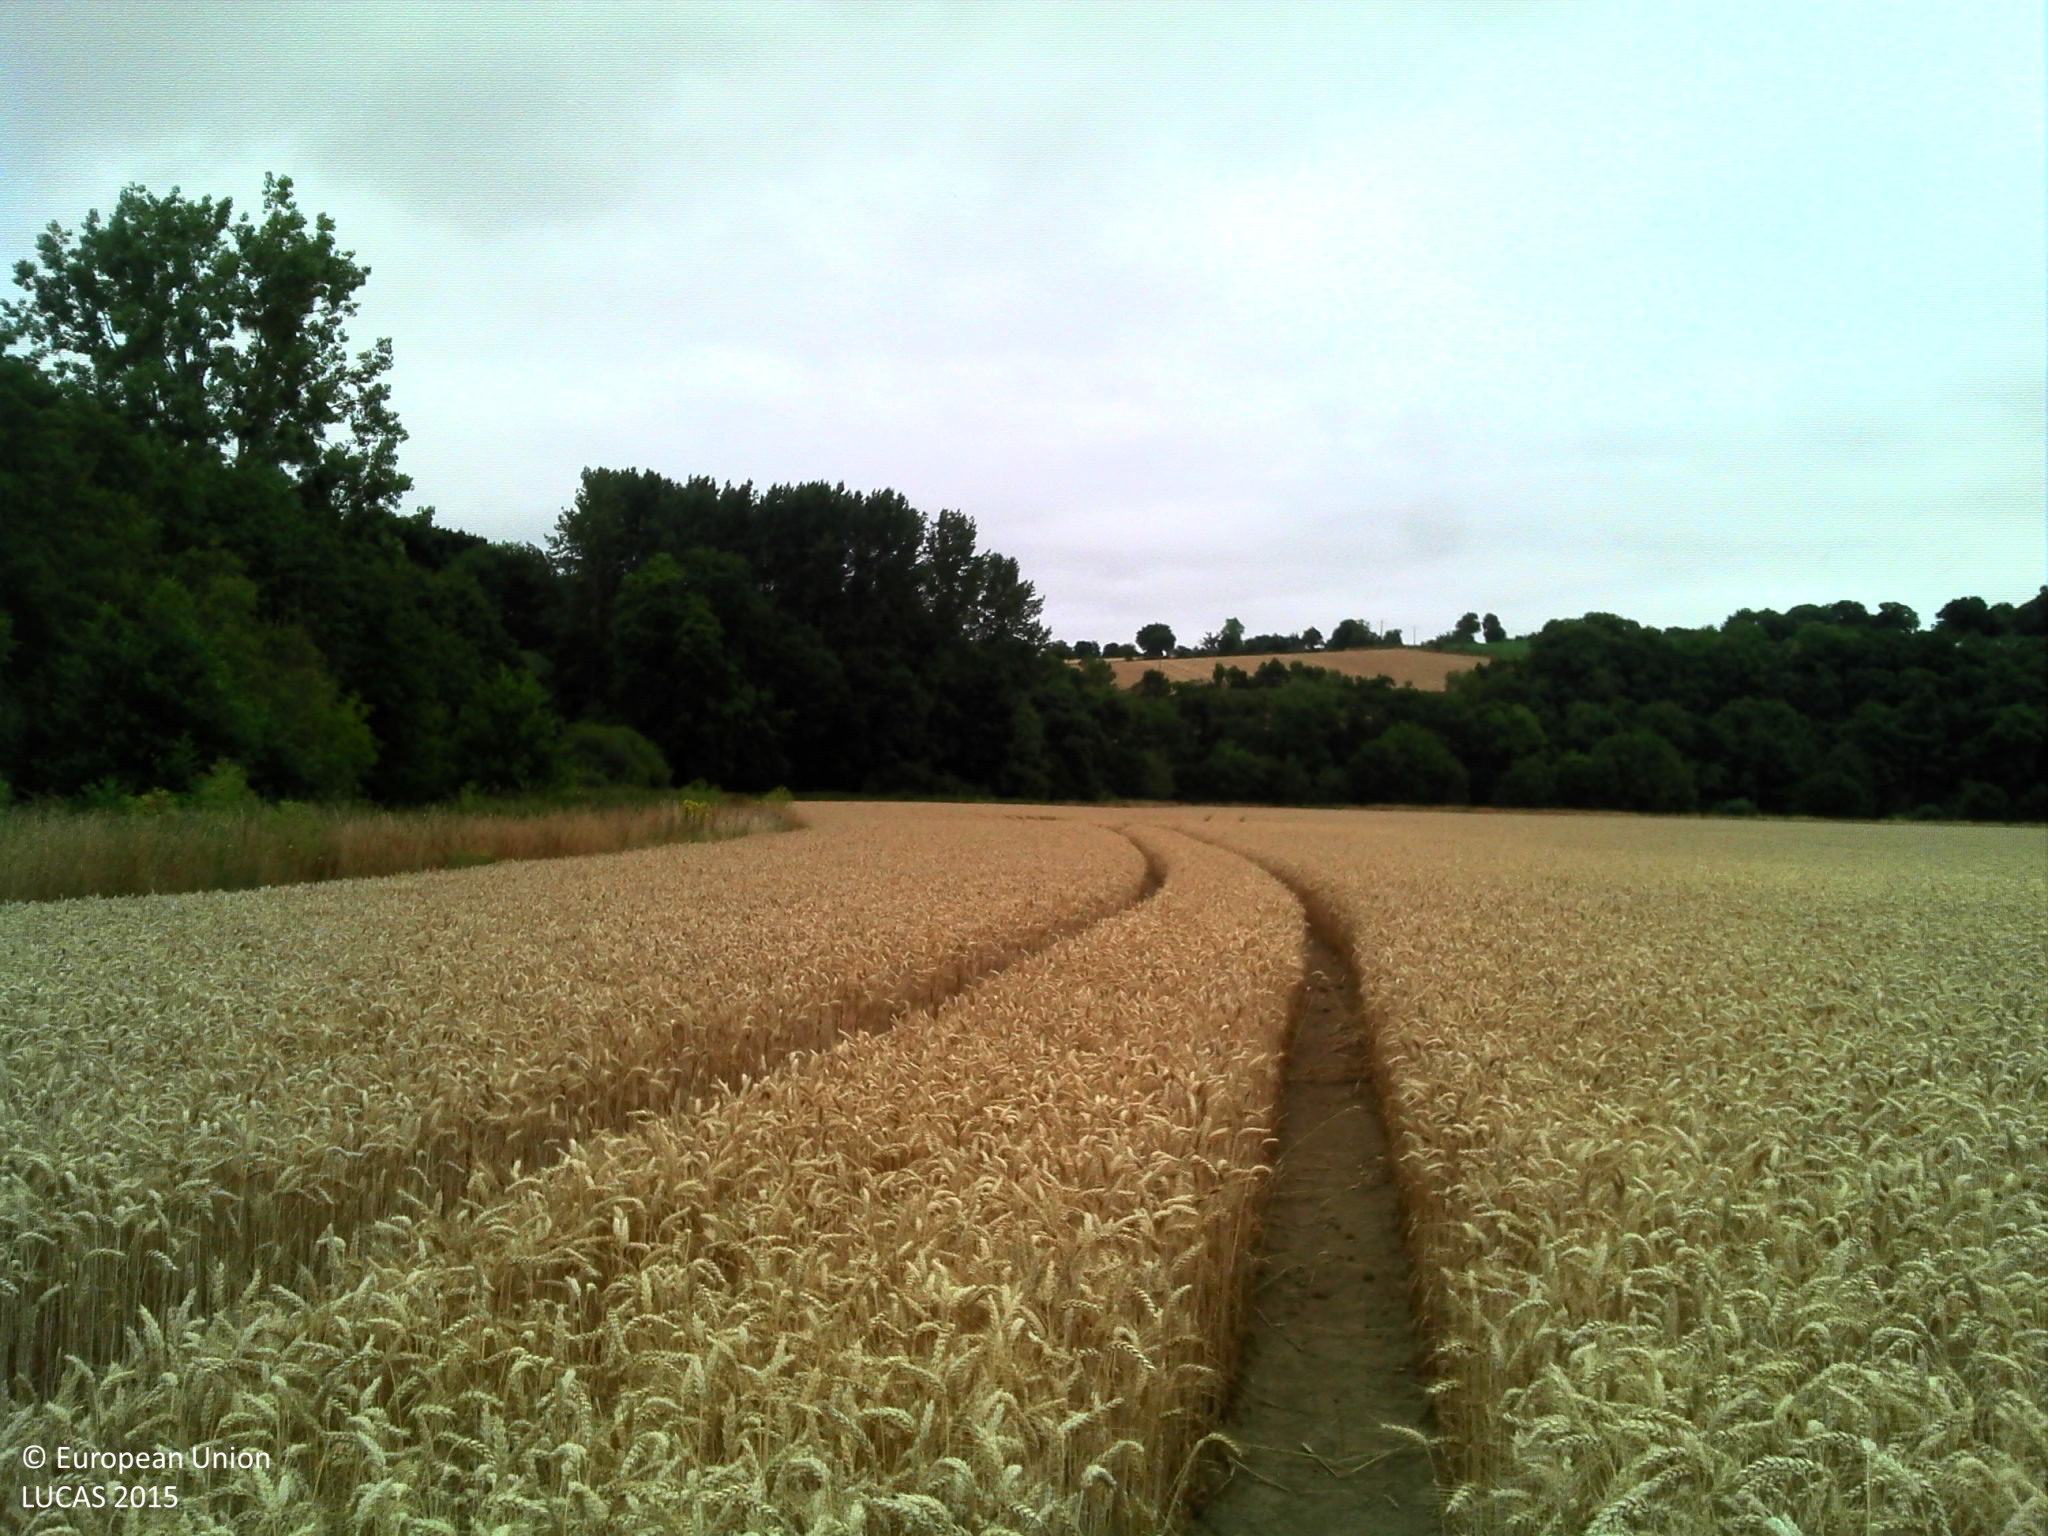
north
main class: Cropland
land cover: Common wheat
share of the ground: > 75 %
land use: Agriculture (excluding fallow land and kitchen gardens)
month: July
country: FR
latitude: 47.8475
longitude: -1.5781
